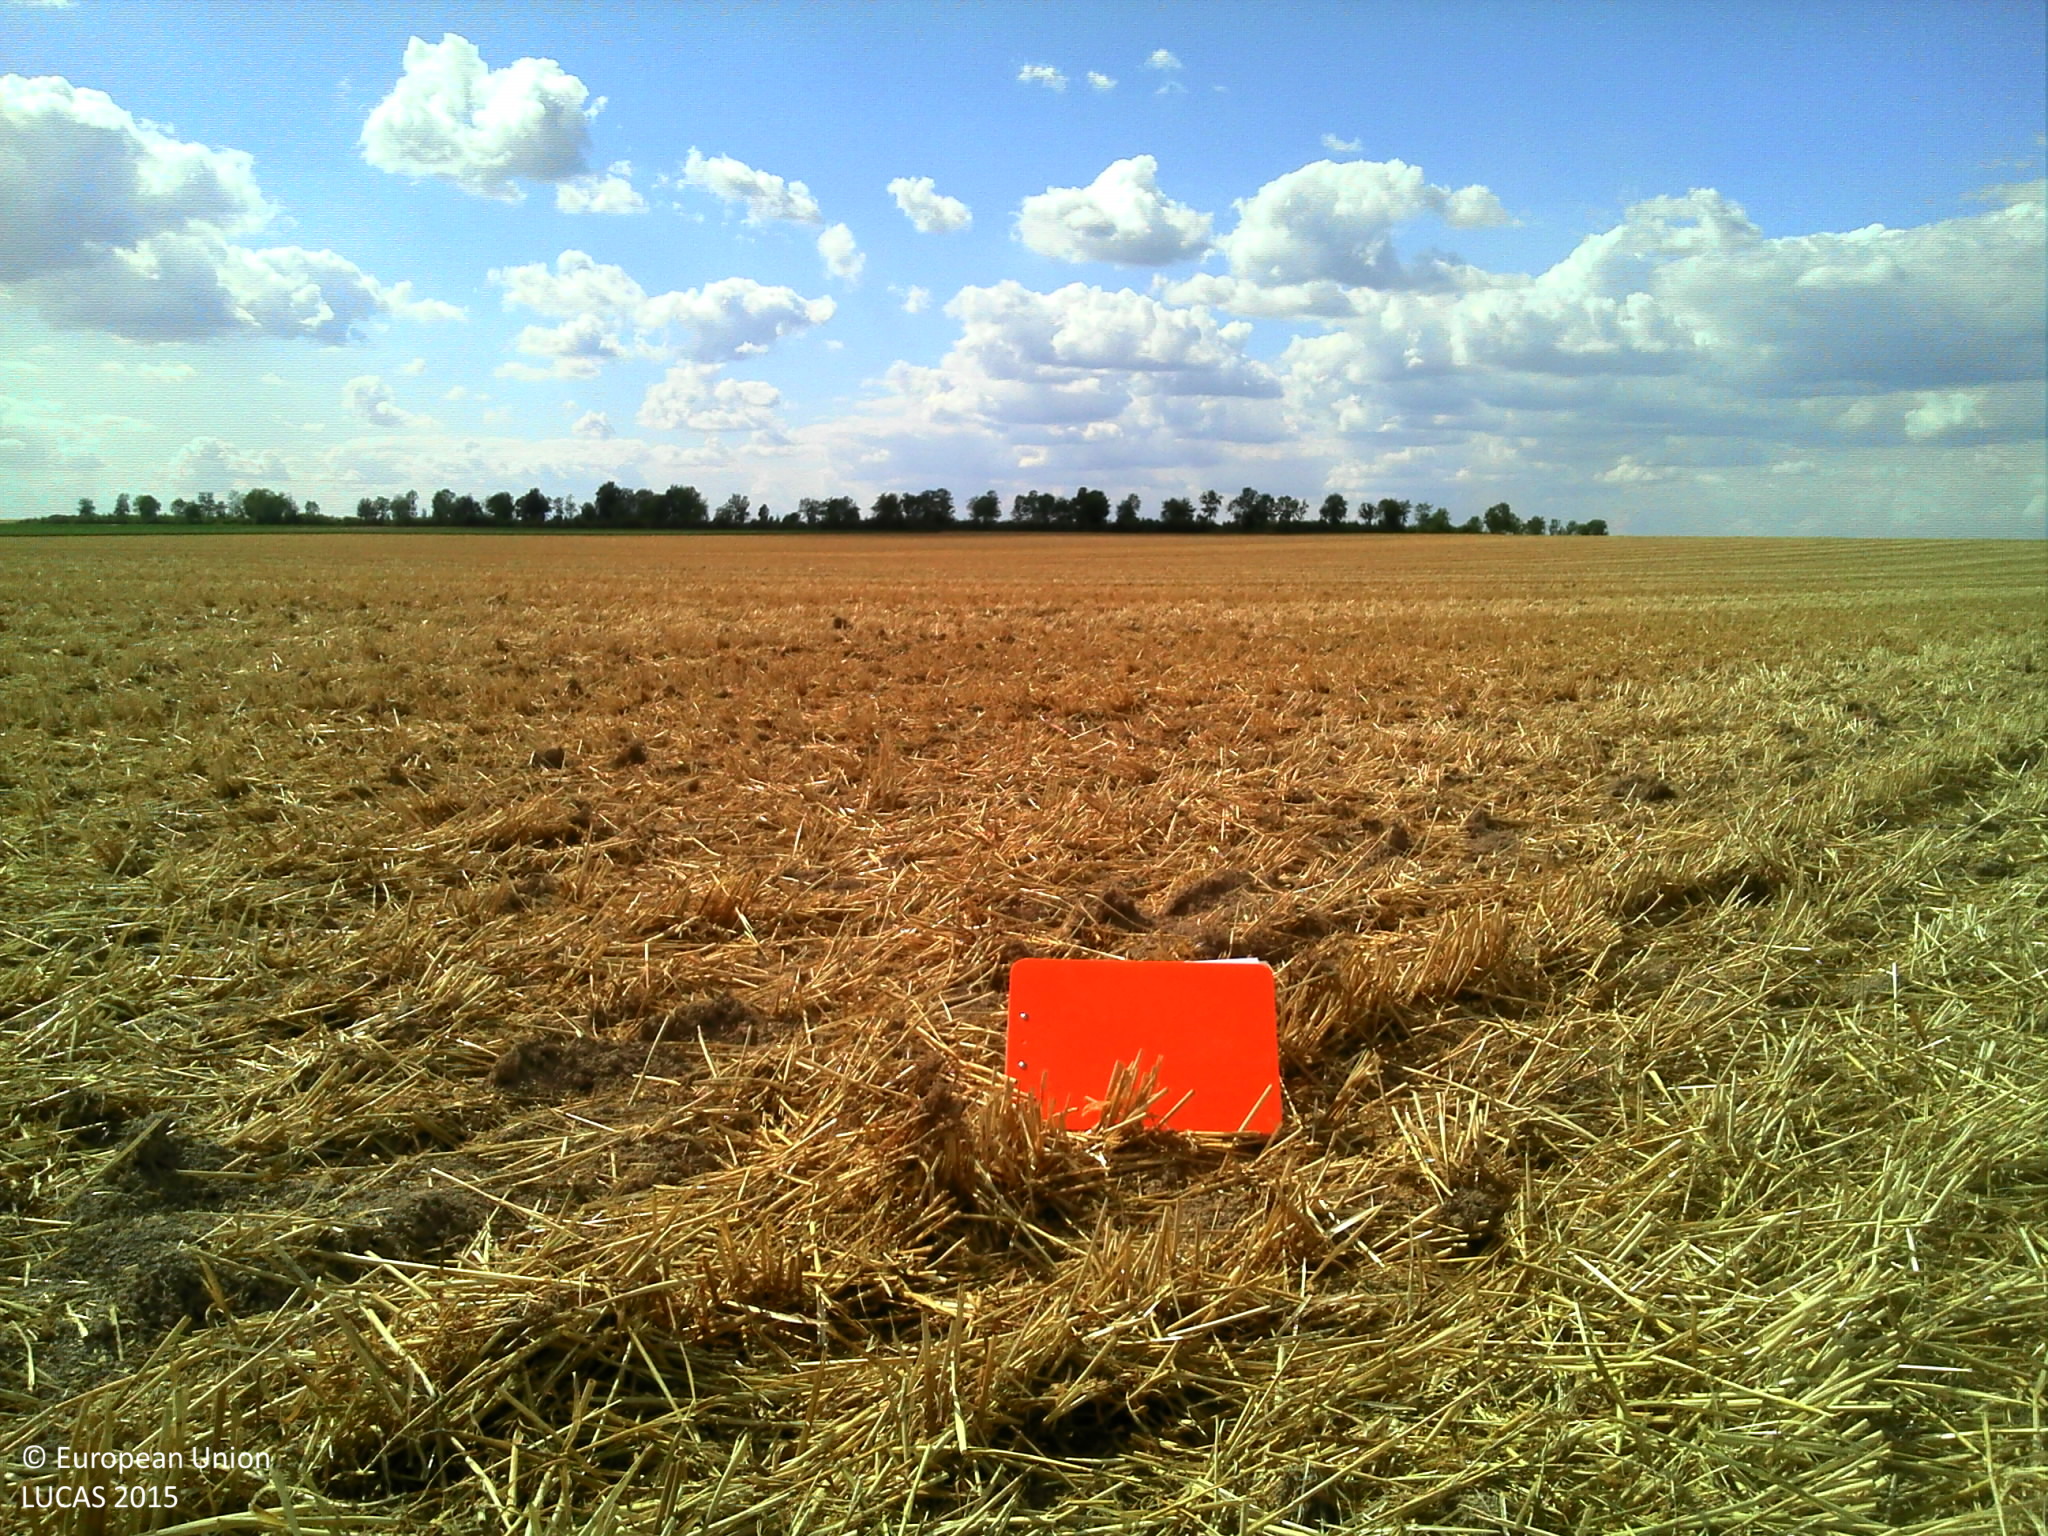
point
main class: Cropland
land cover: Common wheat
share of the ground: > 75 %
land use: Agriculture (excluding fallow land and kitchen gardens)
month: July
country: FR
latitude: 48.9184
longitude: 4.1961
